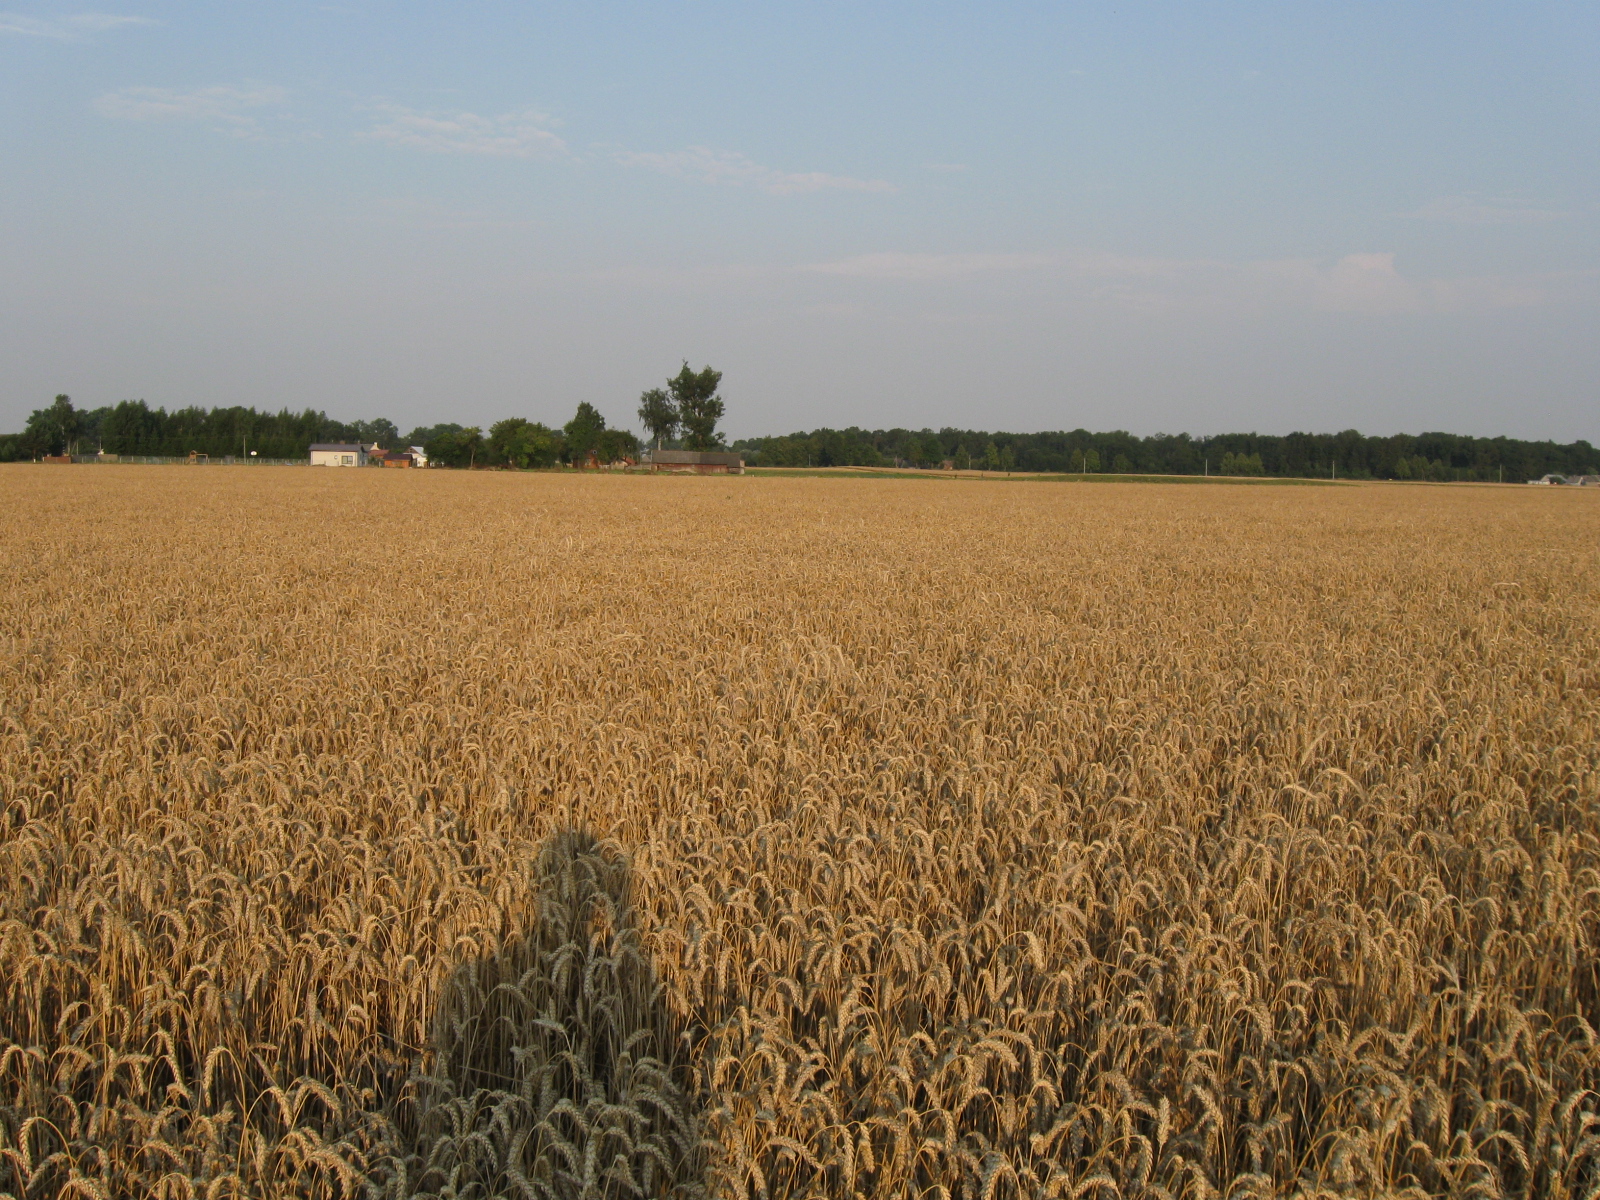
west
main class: Cropland
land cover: Common wheat
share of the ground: > 75 %
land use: Agriculture (excluding fallow land and kitchen gardens)
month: August
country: LT
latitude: 54.5784
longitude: 23.3057
